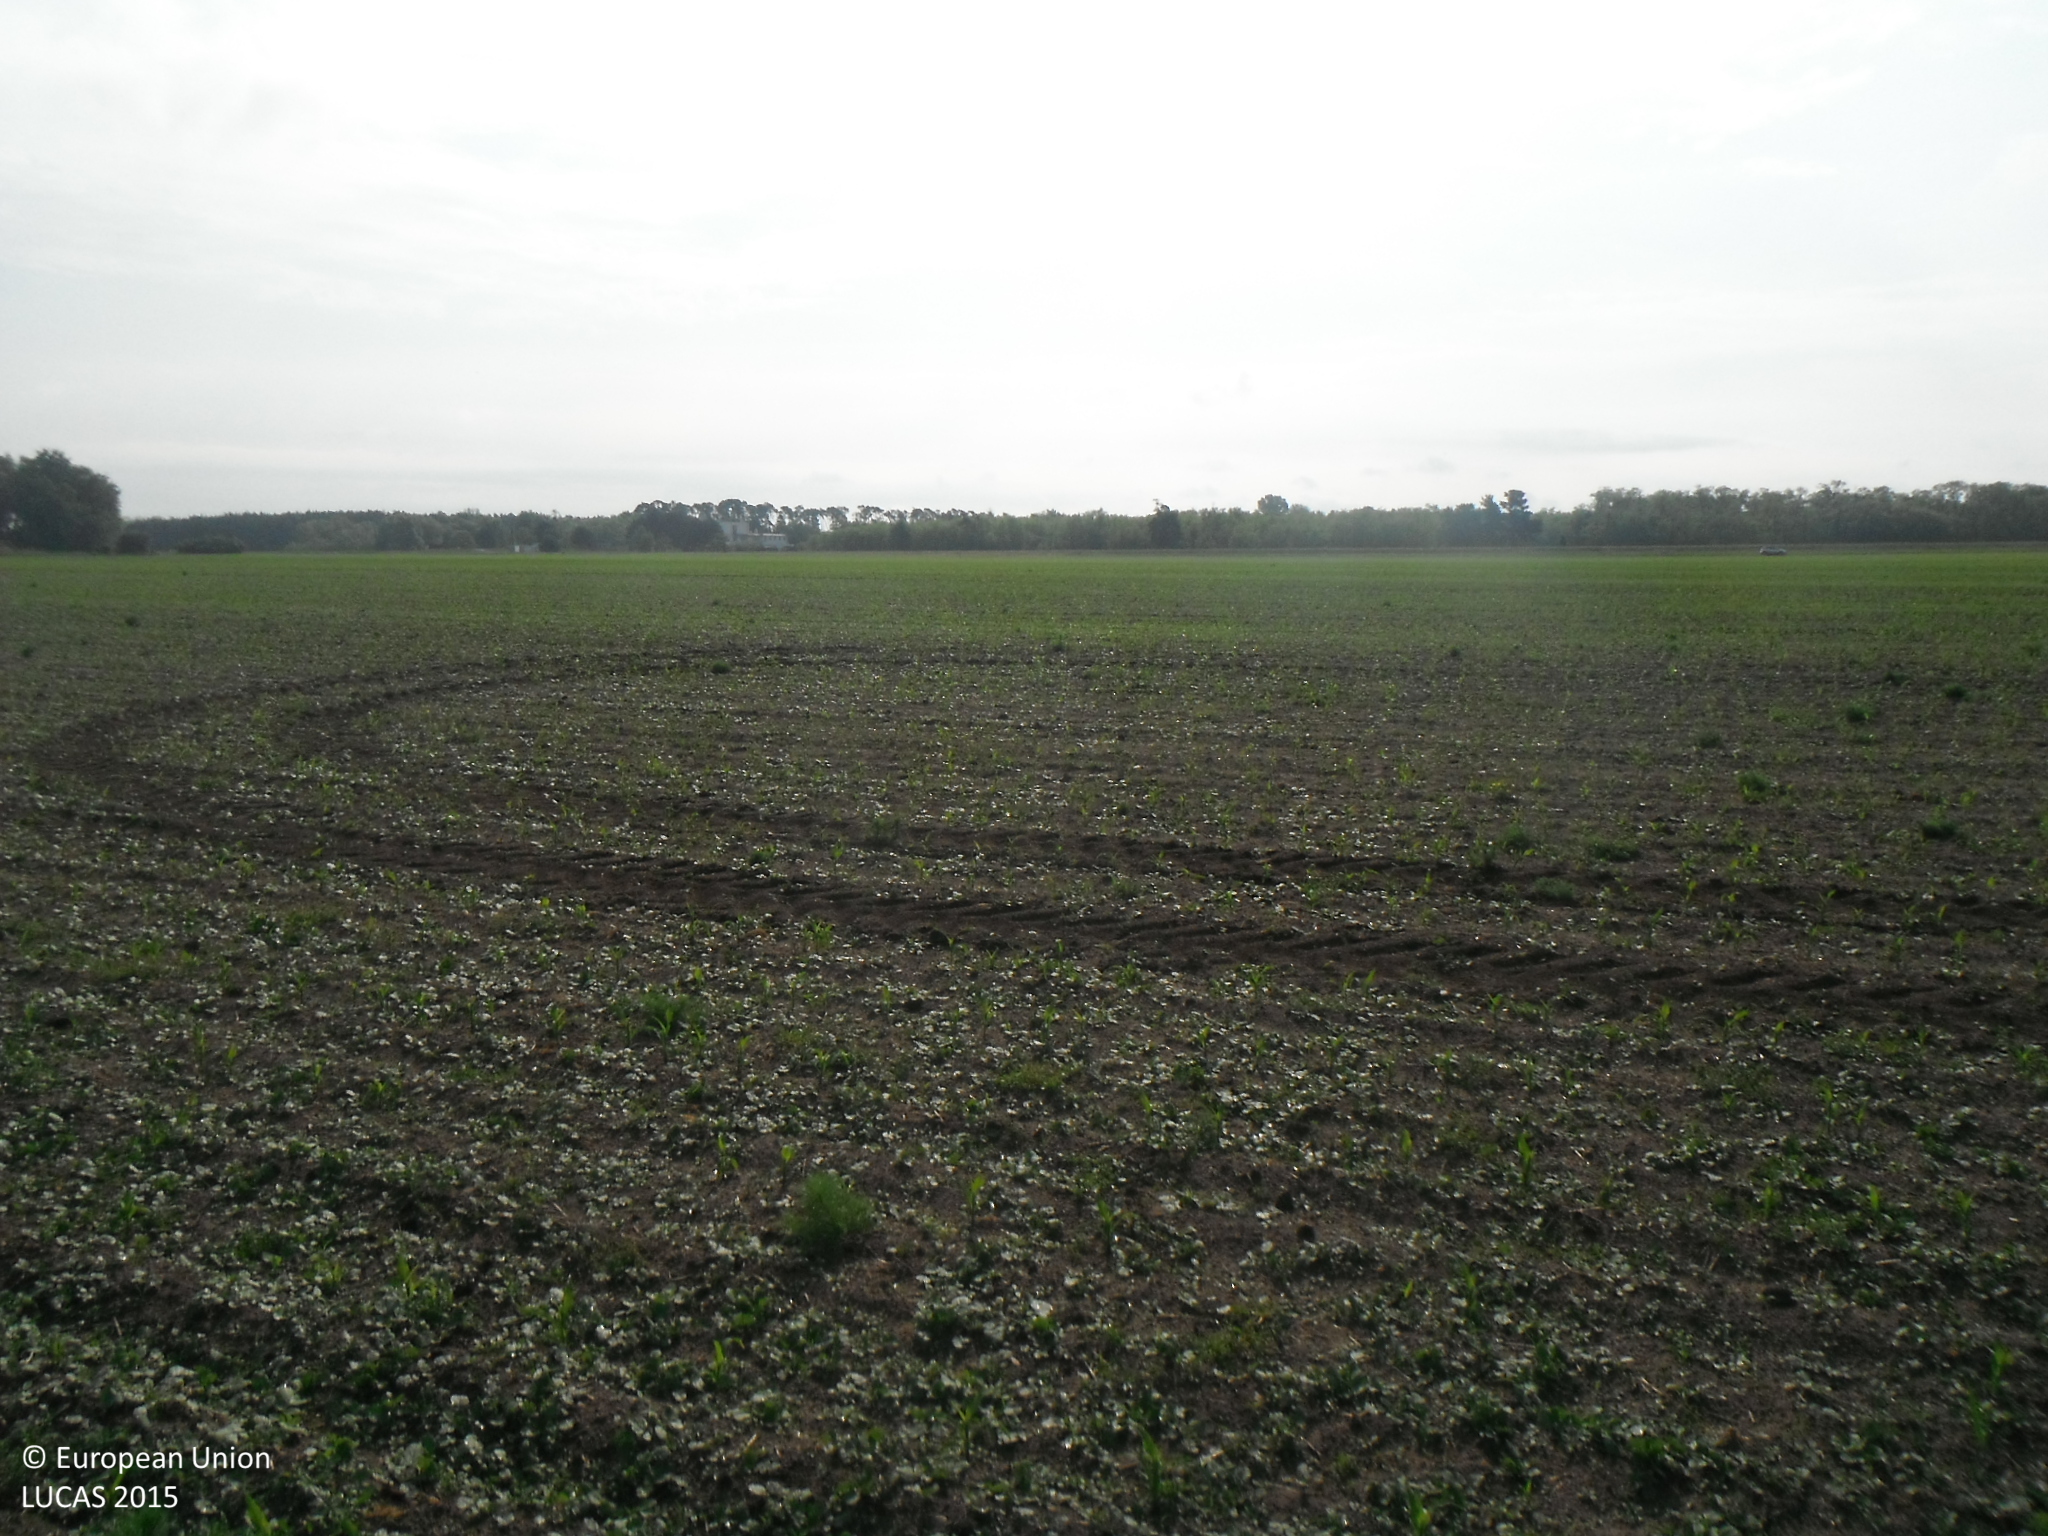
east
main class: Cropland
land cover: Maize
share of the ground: < 10 %
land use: Agriculture (excluding fallow land and kitchen gardens)
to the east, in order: Maize
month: May
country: SK
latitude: 48.5096
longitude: 16.9520
